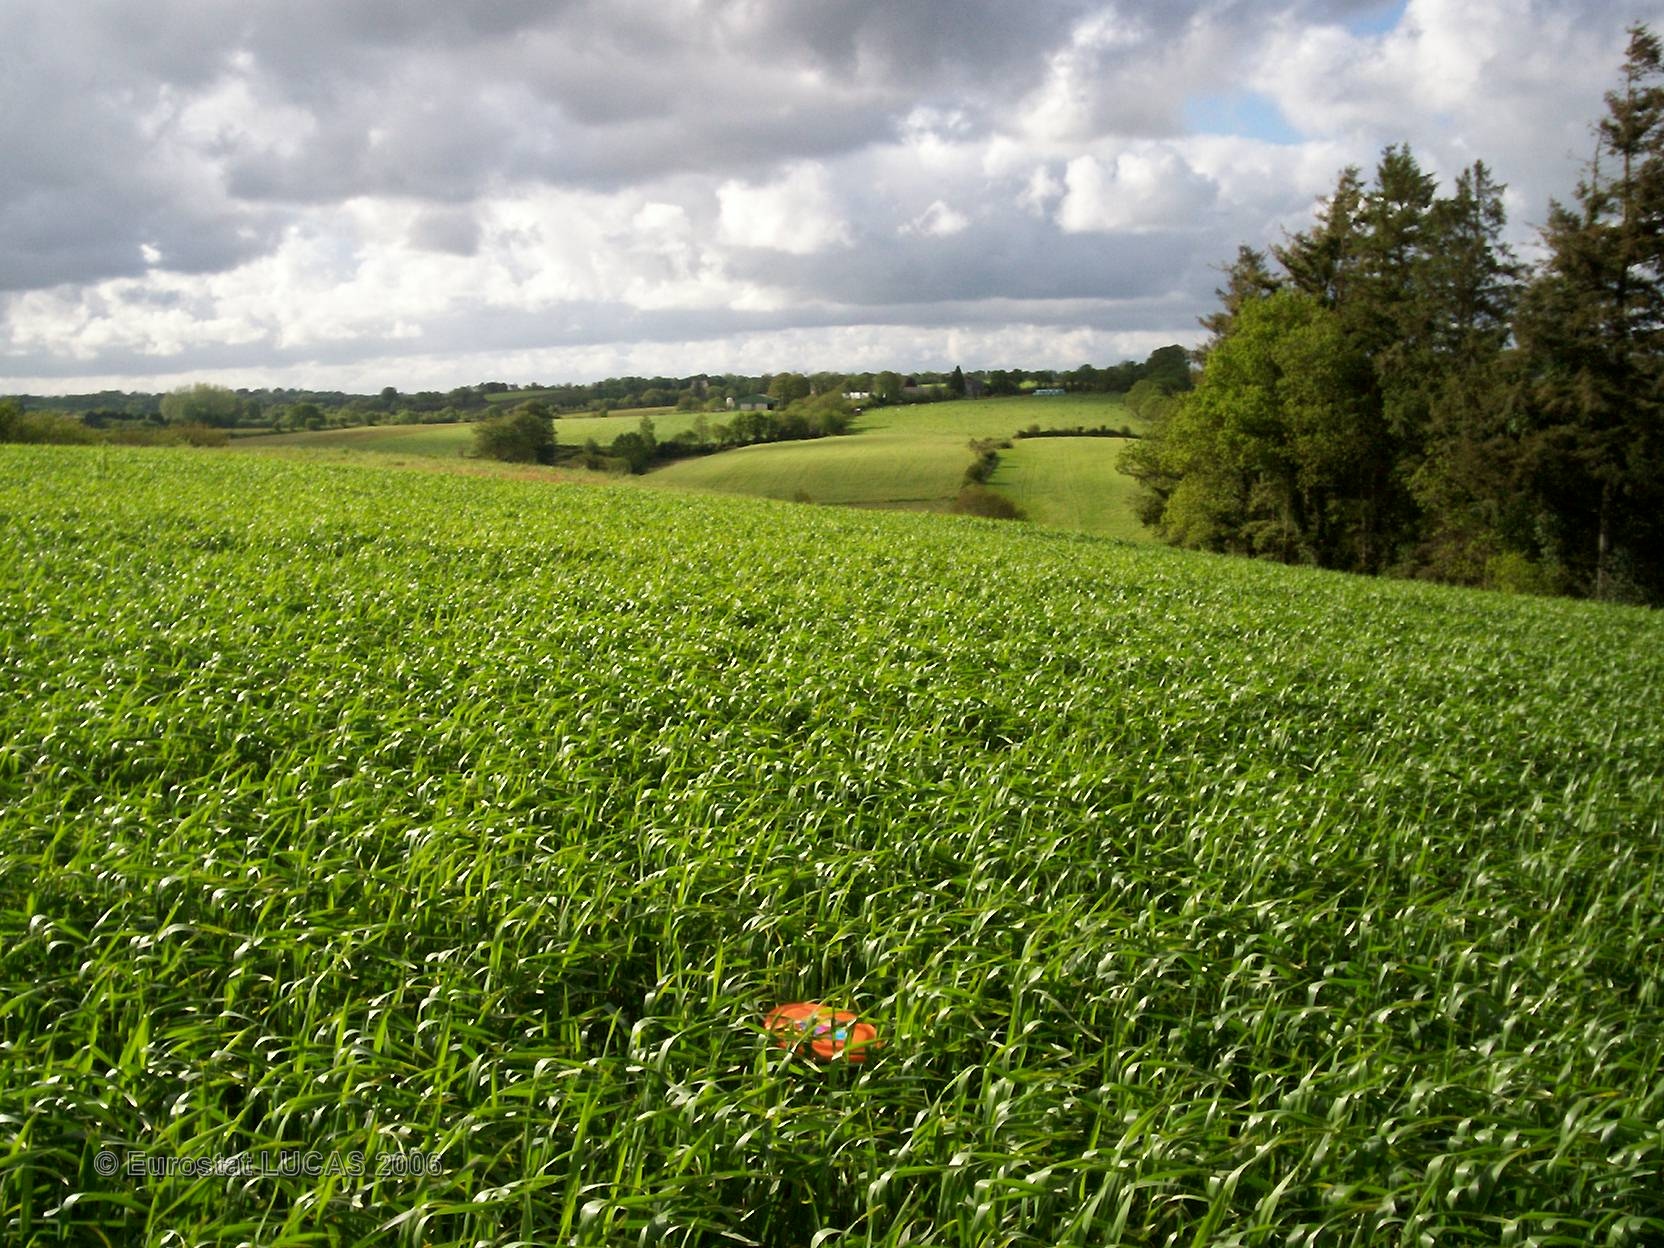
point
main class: Cropland
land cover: Common wheat
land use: Agriculture (excluding fallow land and kitchen gardens)
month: May
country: FR
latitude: 47.9981
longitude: -3.8745
